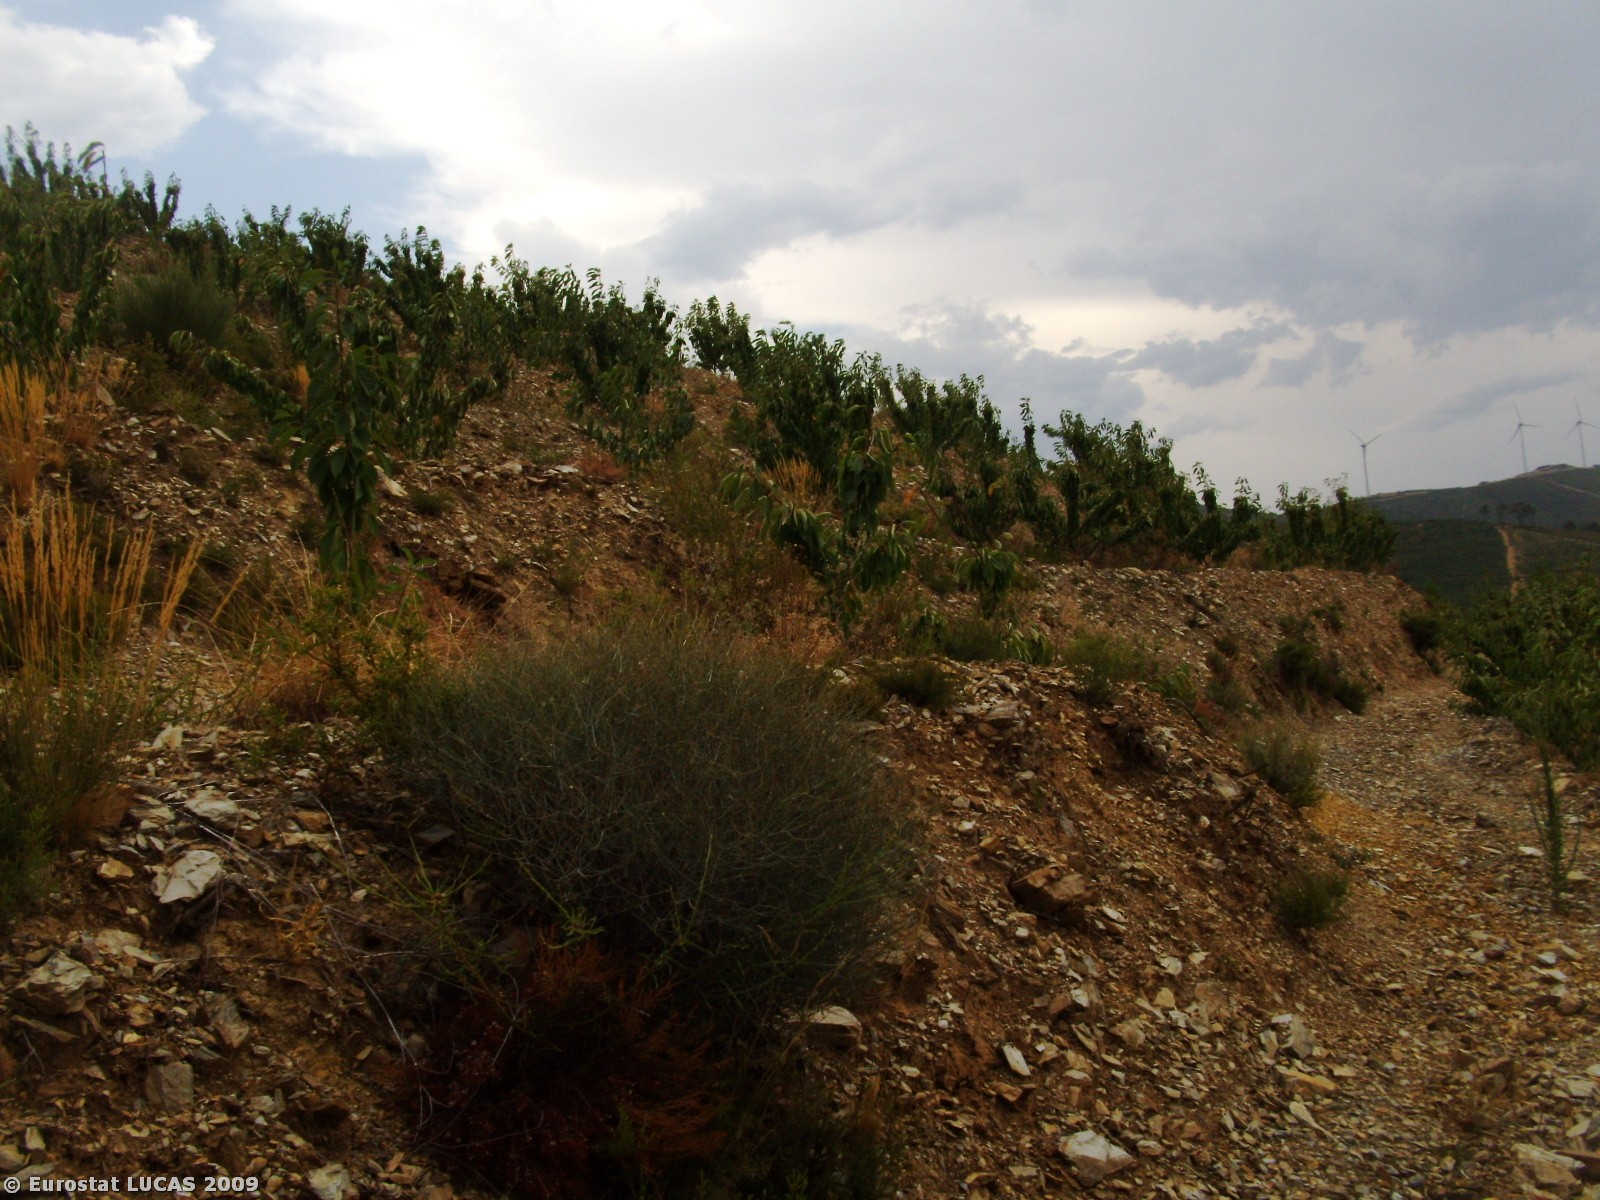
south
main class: Cropland
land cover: Cherry fruit
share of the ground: 25 - 50 %
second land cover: Bare land
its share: > 75 %
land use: Agriculture (excluding fallow land and kitchen gardens)
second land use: Fallow land
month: August
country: PT
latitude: 40.1027
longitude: -7.5973
